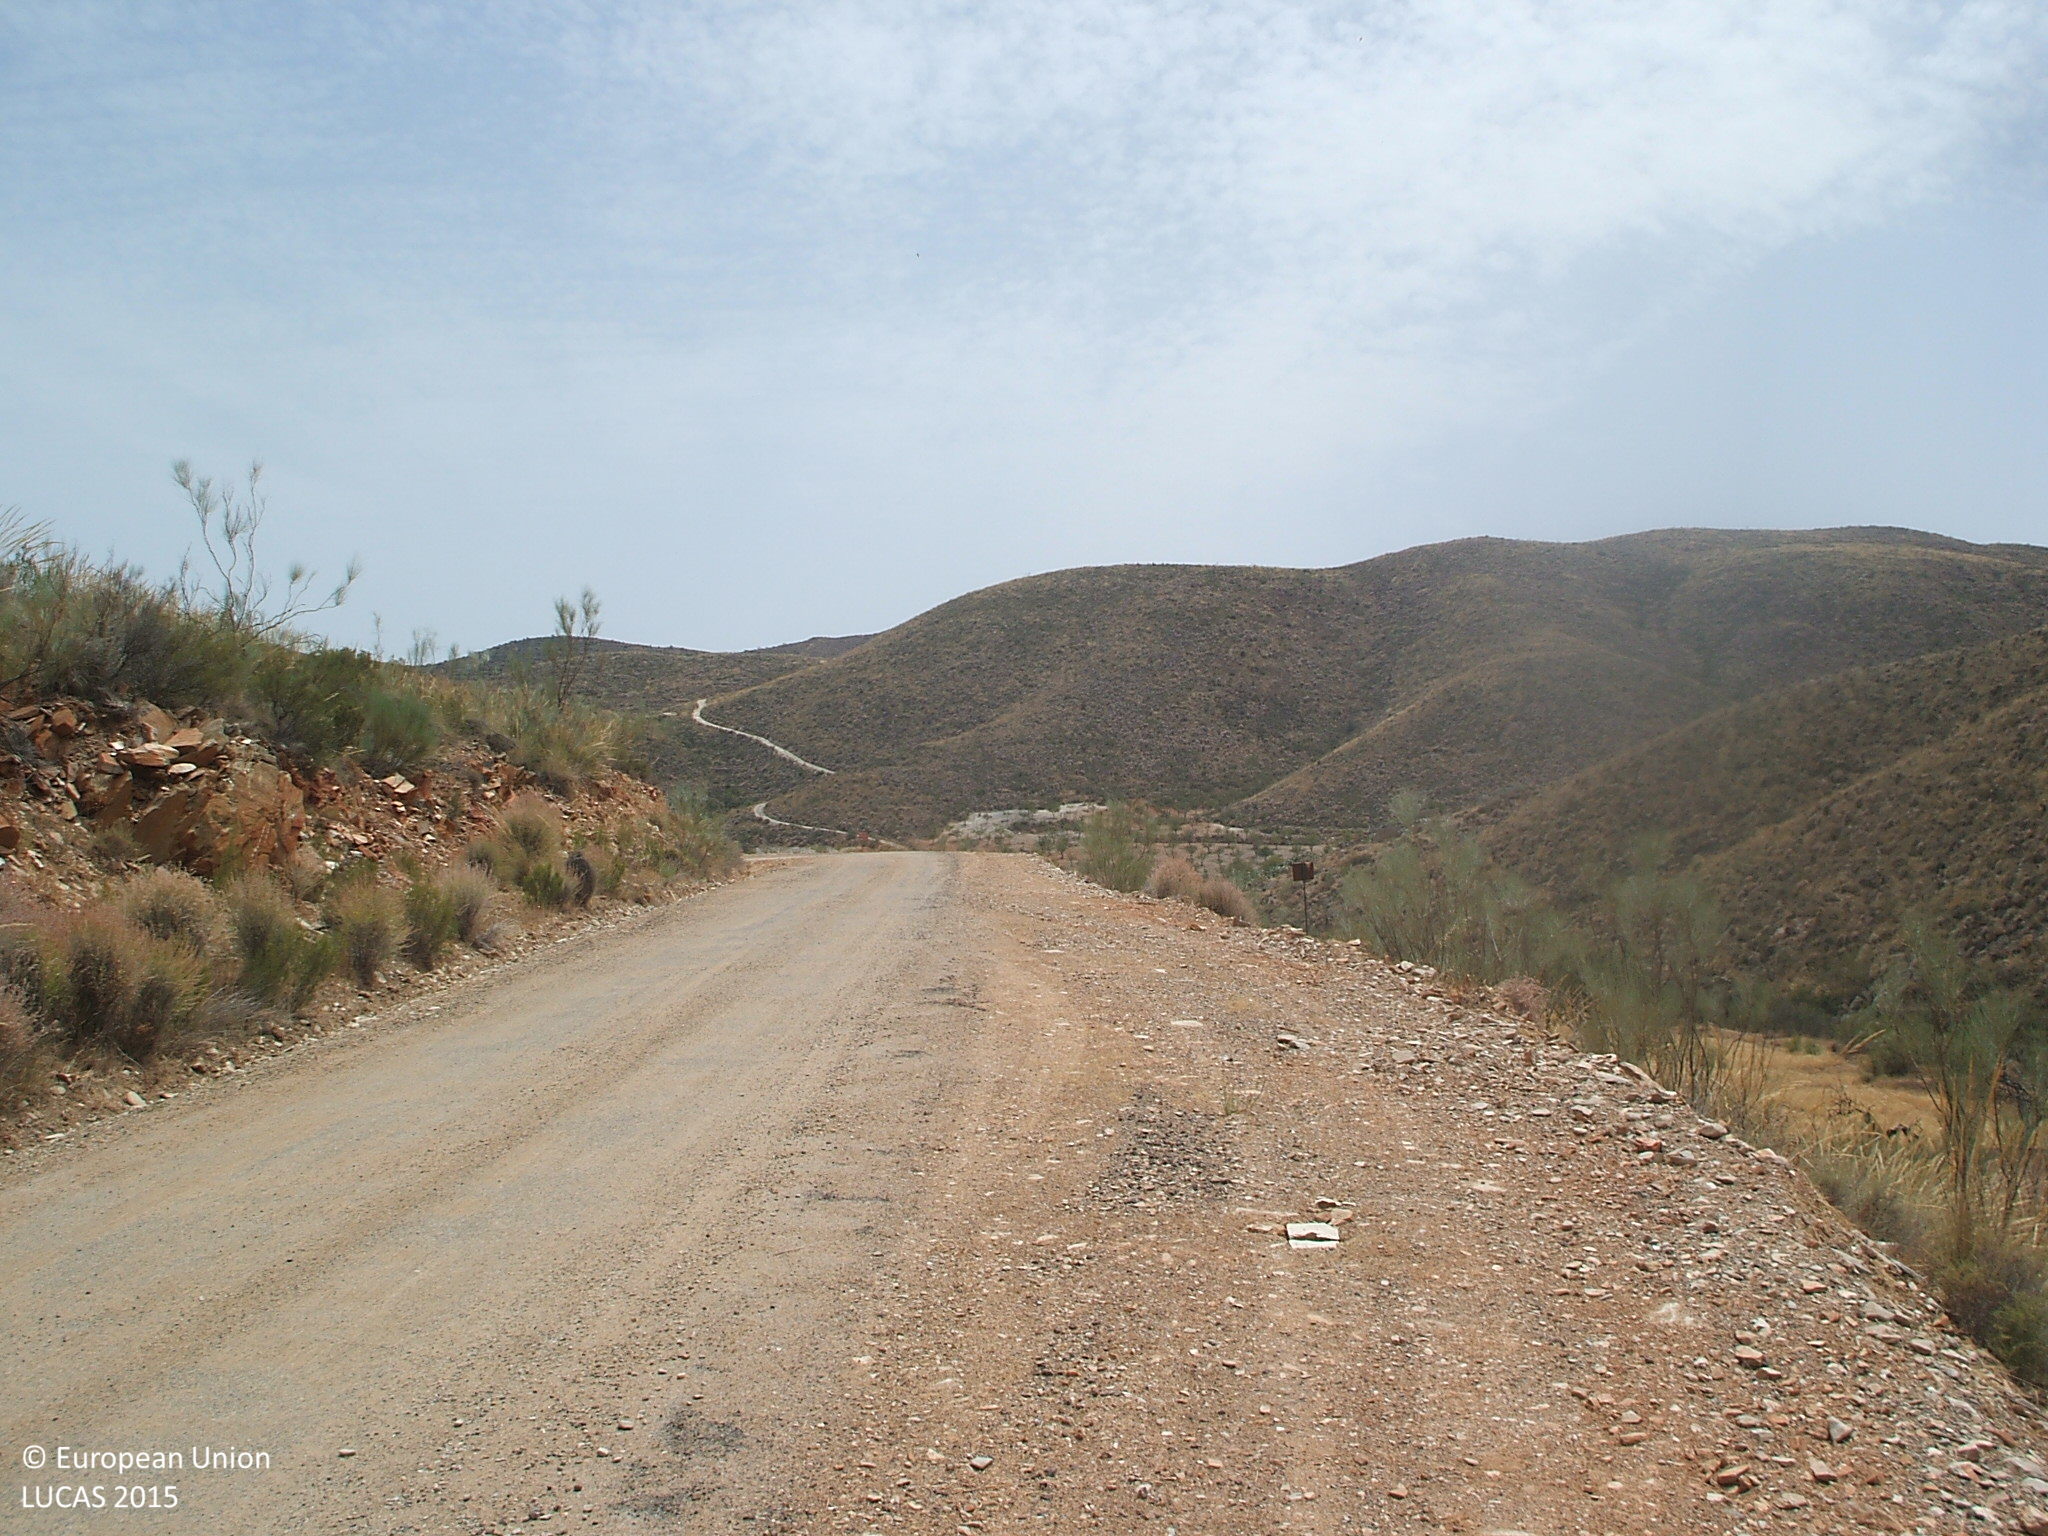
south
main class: Shrubland
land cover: Shrubland without tree cover
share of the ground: 50 - 75 %
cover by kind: shrubs 60 %, consolidated bare surface 40 %
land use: Semi-natural and natural areas not in use
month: July
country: ES
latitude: 37.1701
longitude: -2.2659
